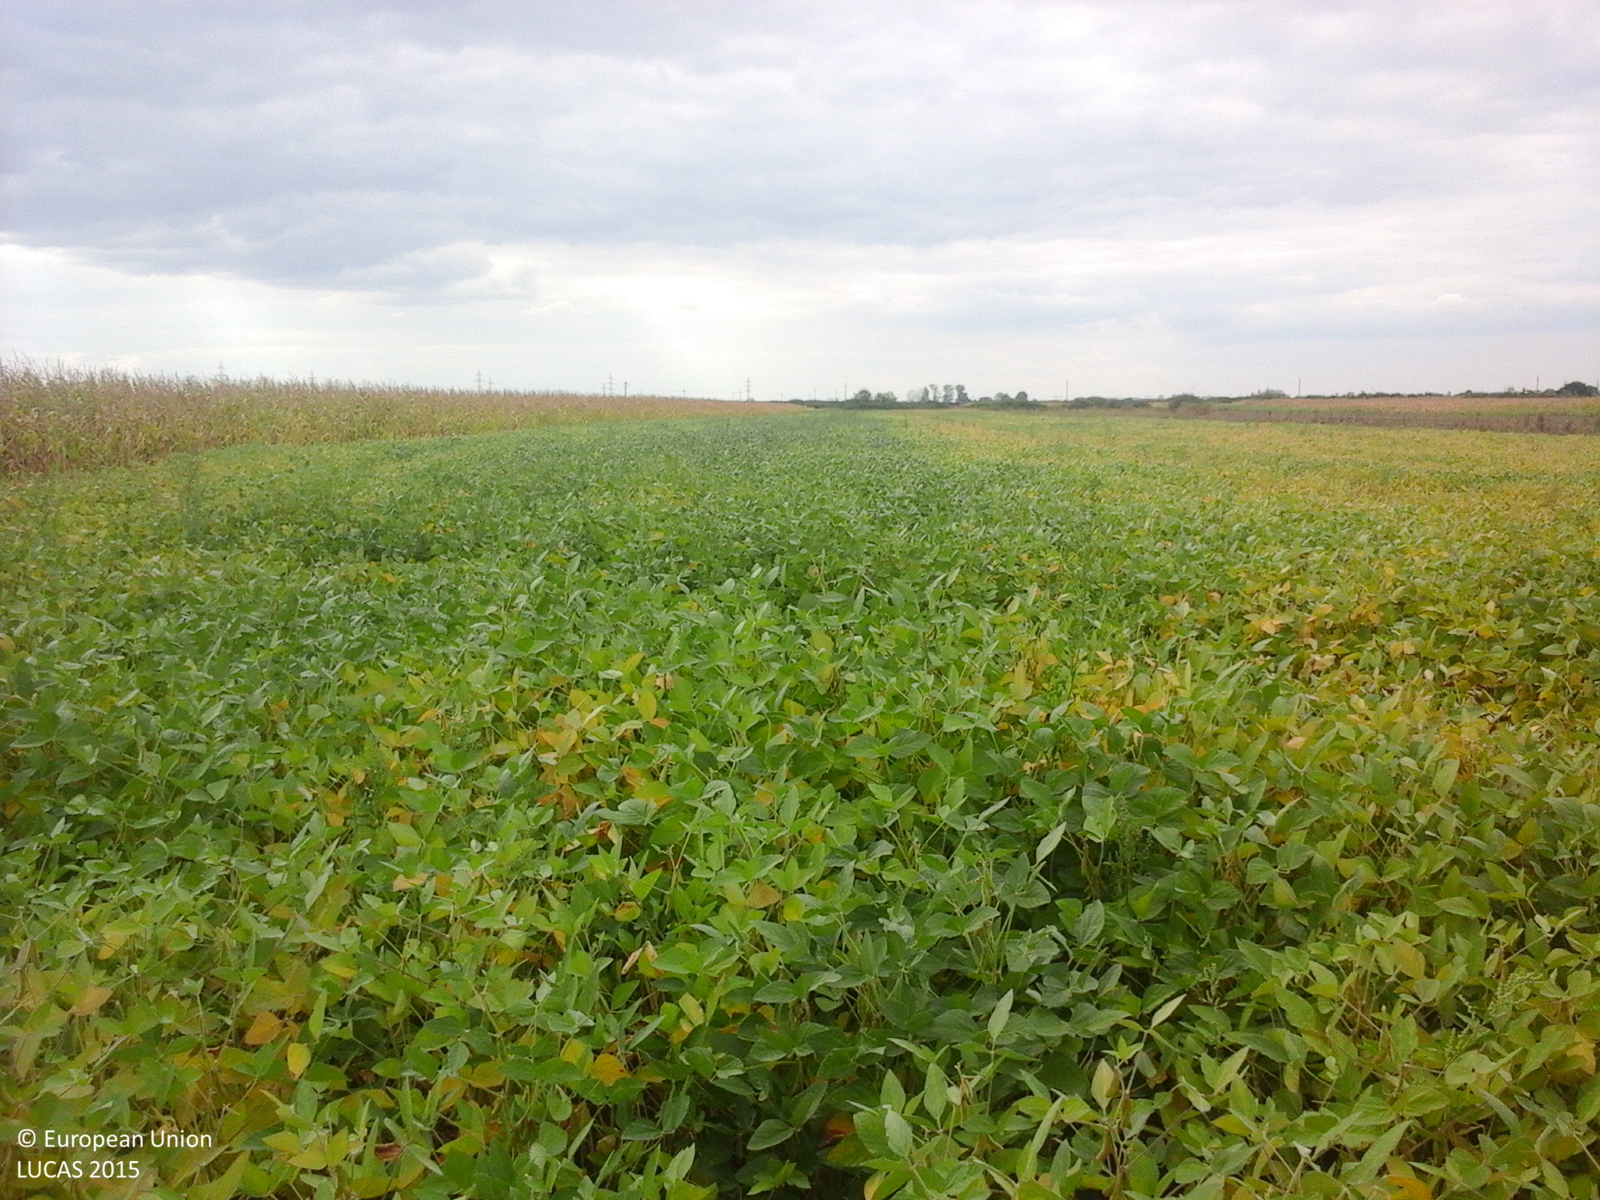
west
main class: Cropland
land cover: Soya
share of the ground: > 75 %
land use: Agriculture (excluding fallow land and kitchen gardens)
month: September
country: RO
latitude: 47.7635
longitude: 22.9676
